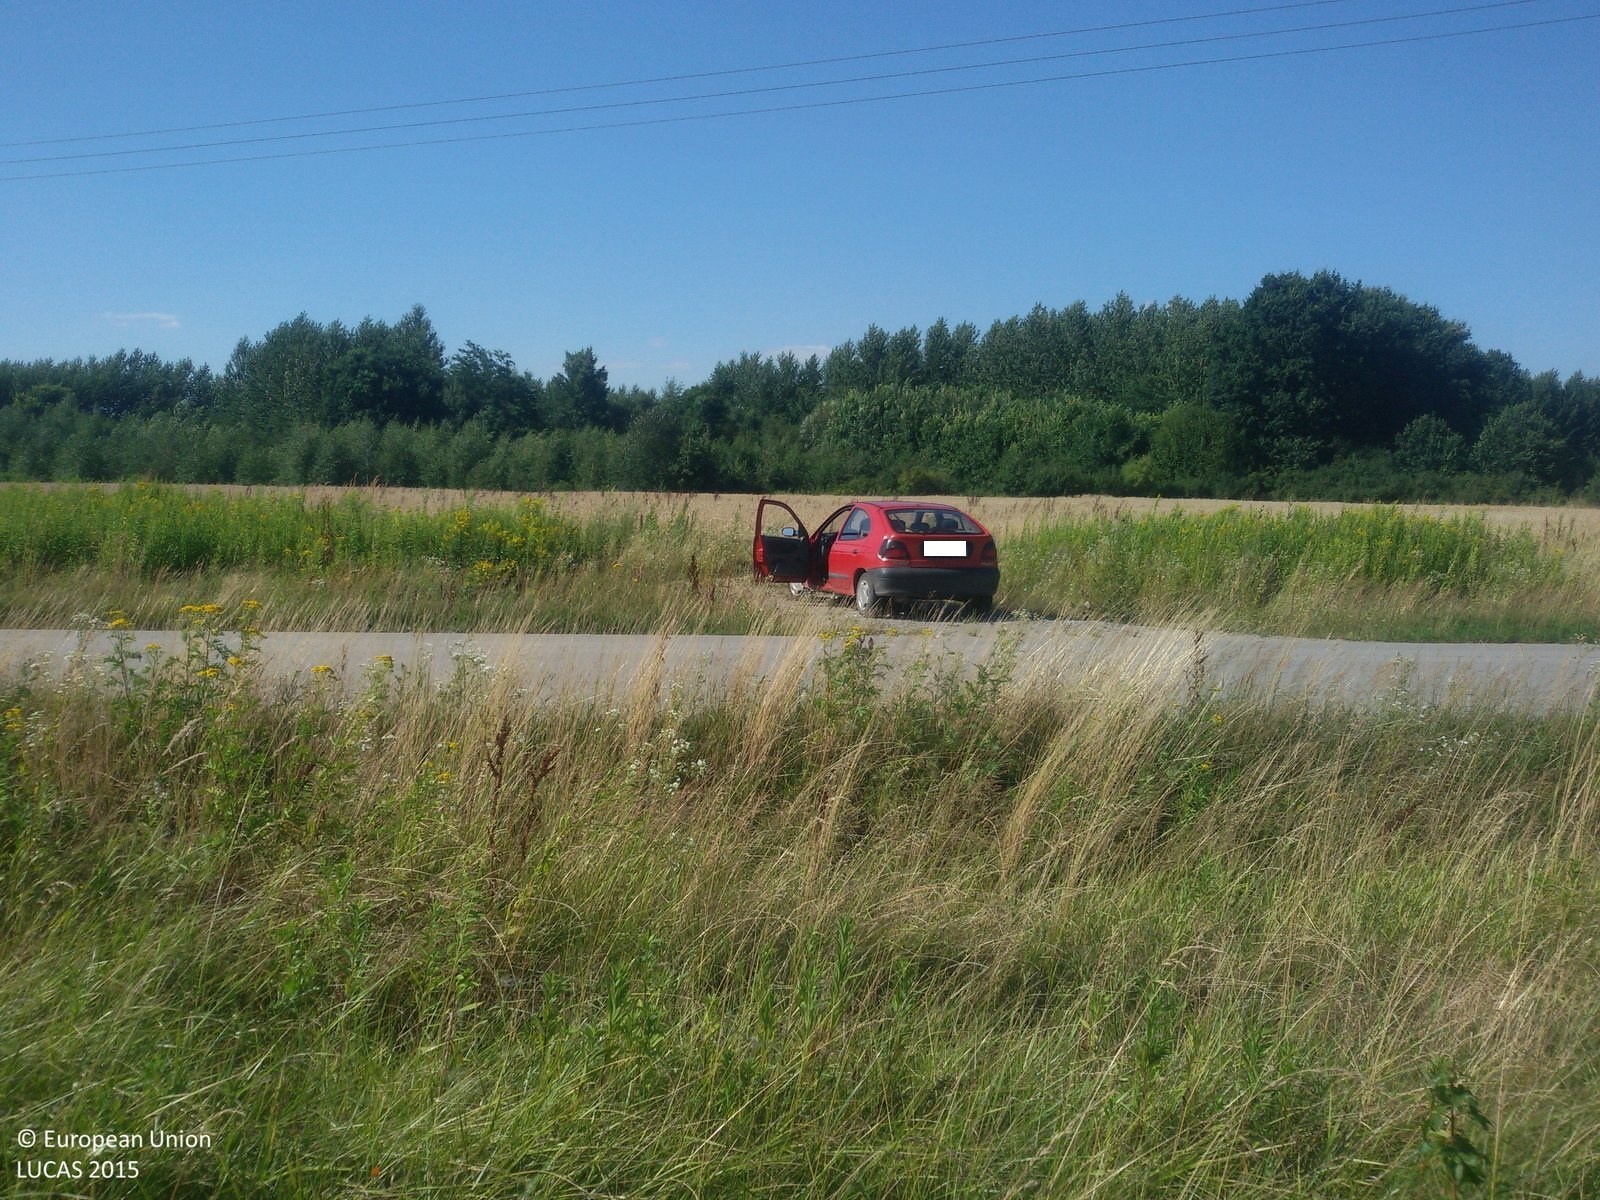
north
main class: Grassland
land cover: Grassland without tree/shrub cover
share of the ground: > 75 %
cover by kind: herbaceous plants 100 %
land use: Road transport
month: July
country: PL
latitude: 50.0044
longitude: 20.7137
